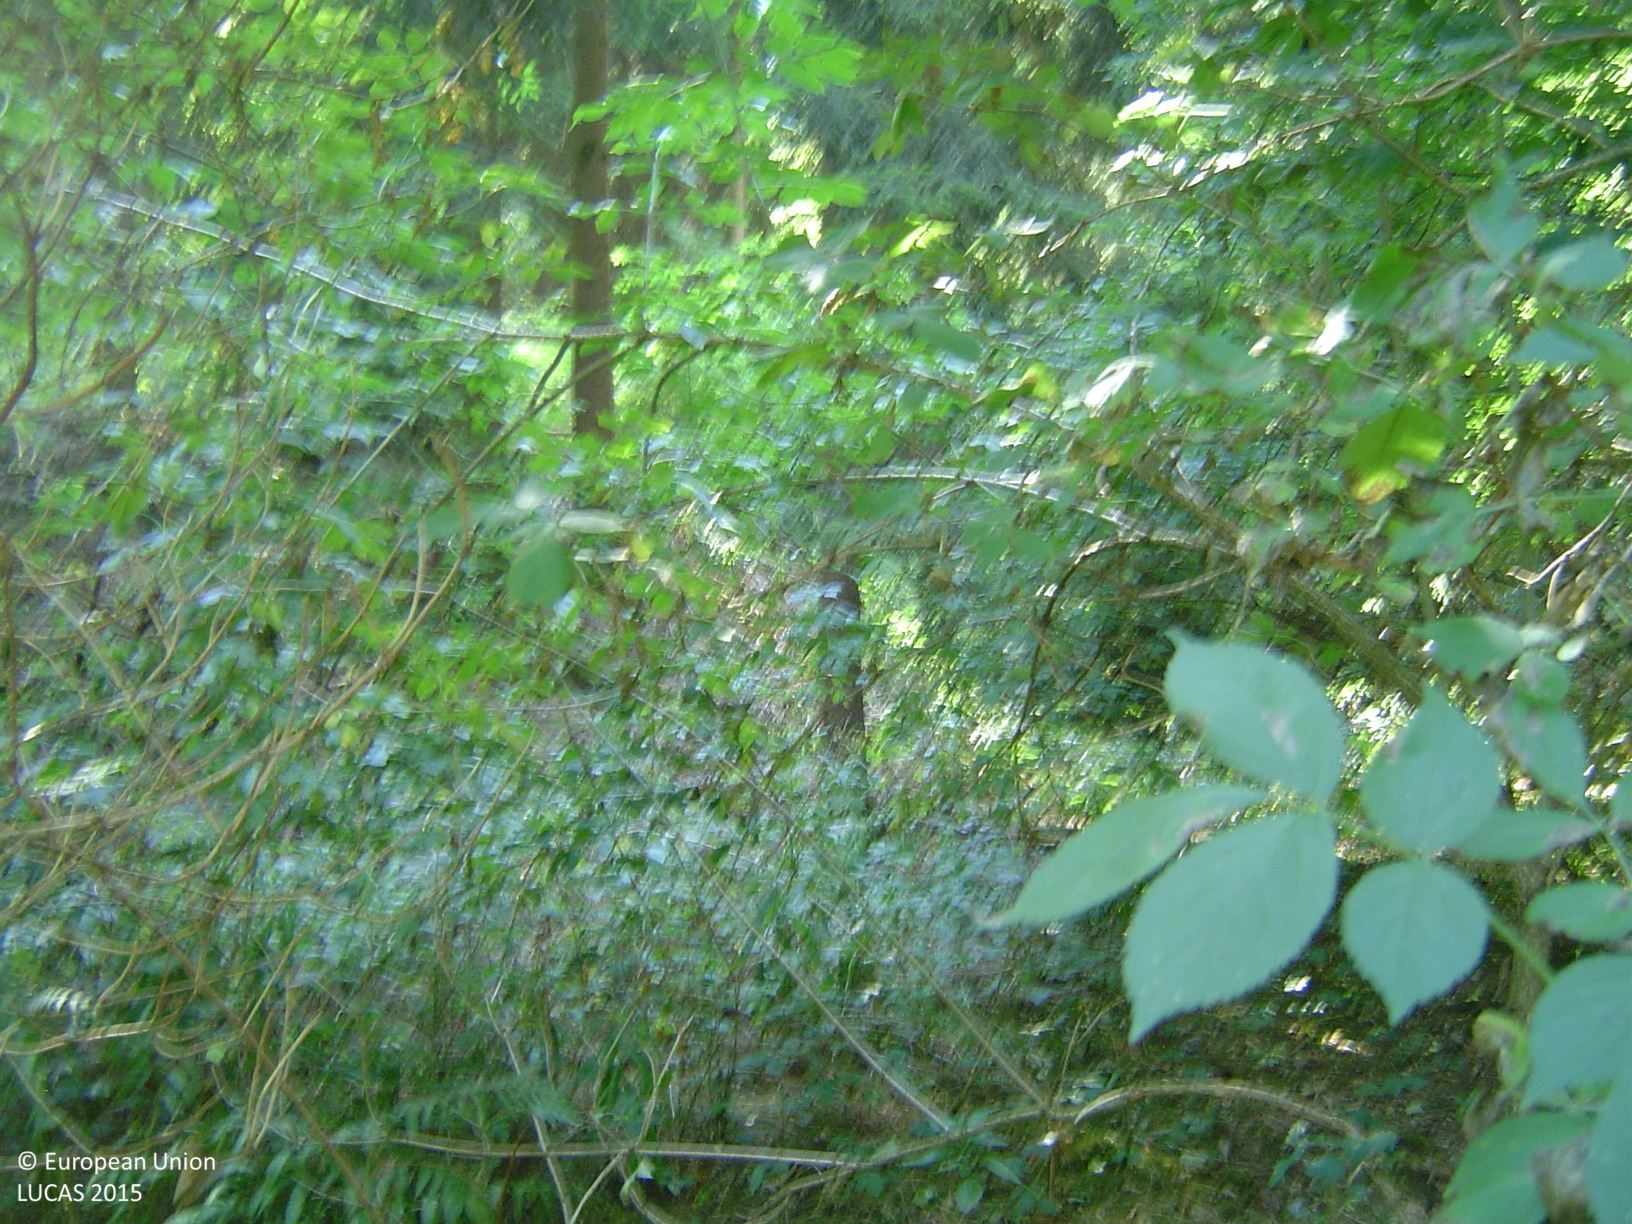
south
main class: Woodland
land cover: Broadleaved woodland
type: mesophytic deciduous forest
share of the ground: > 75 %
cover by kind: broadleaved forest trees 80 %, coniferous forest trees 10 %, shrubs 10 %
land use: Forestry
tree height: > 5 m
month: August
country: CZ
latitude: 49.6315
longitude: 14.3903
